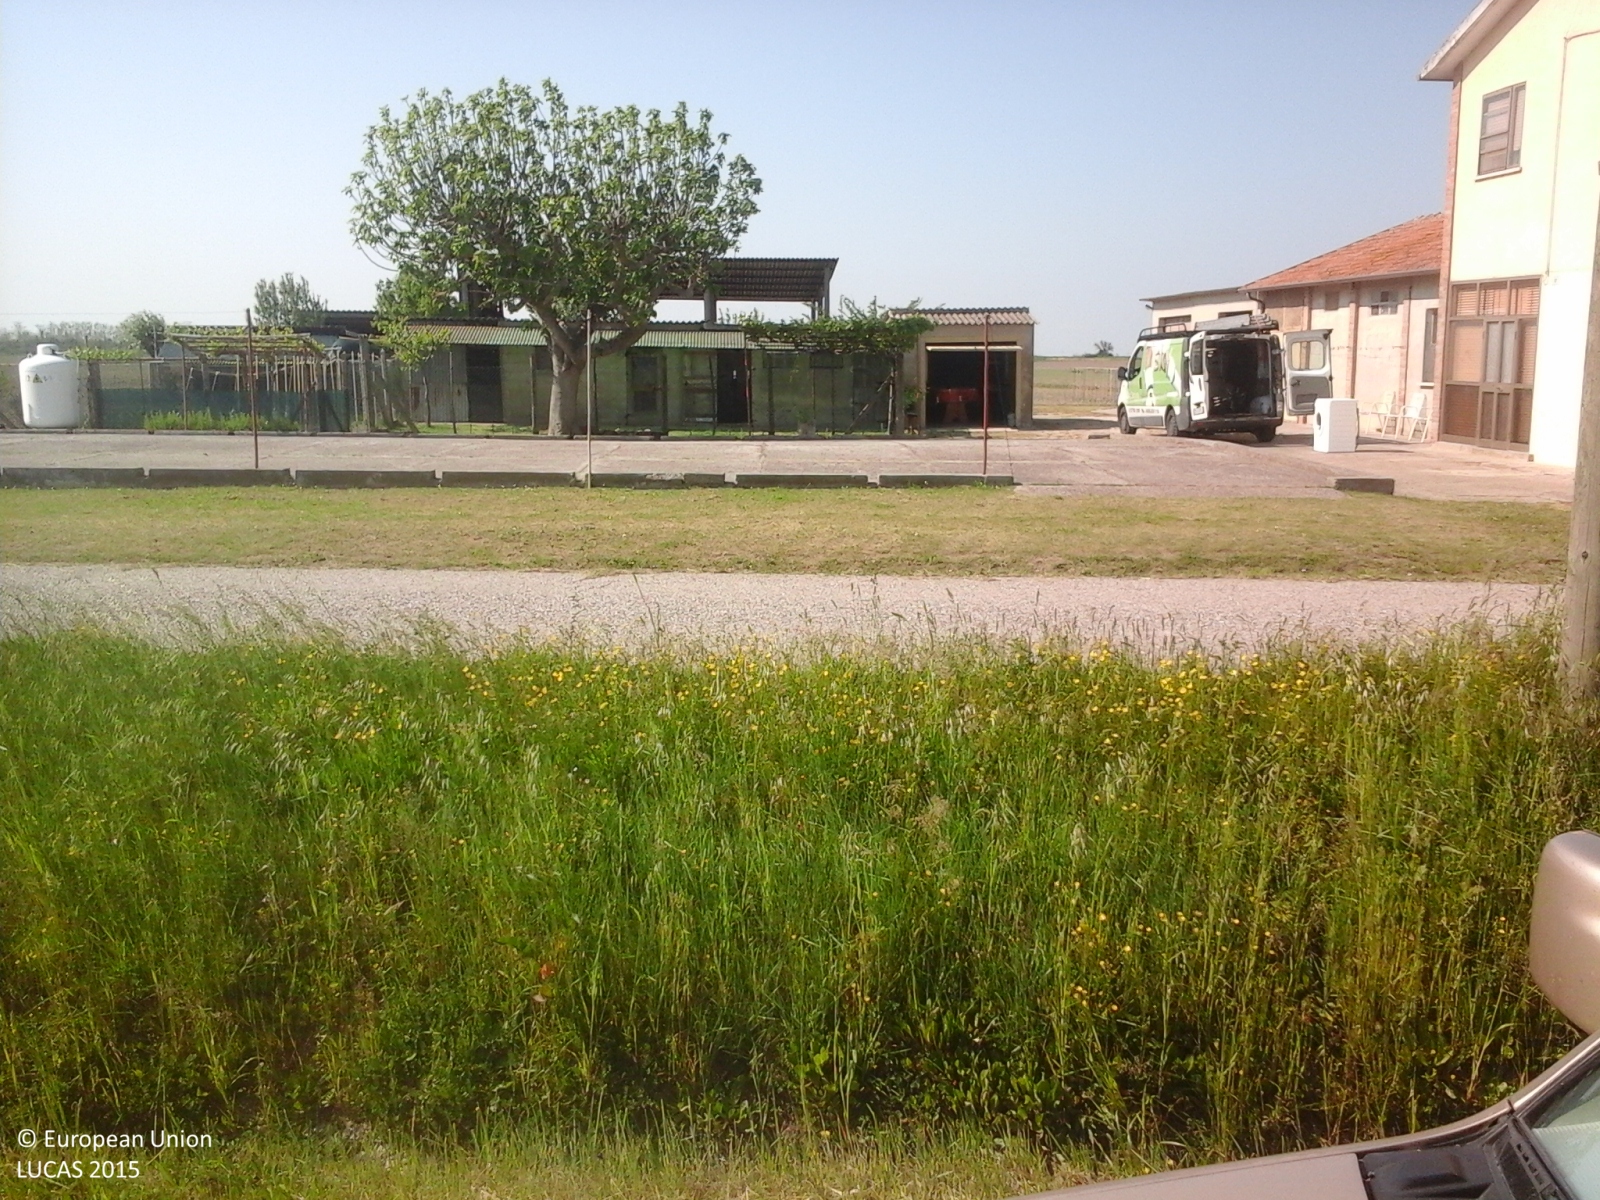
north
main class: Cropland
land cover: Common wheat
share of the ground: > 75 %
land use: Agriculture (excluding fallow land and kitchen gardens)
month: April
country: IT
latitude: 45.0287
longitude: 12.2932
